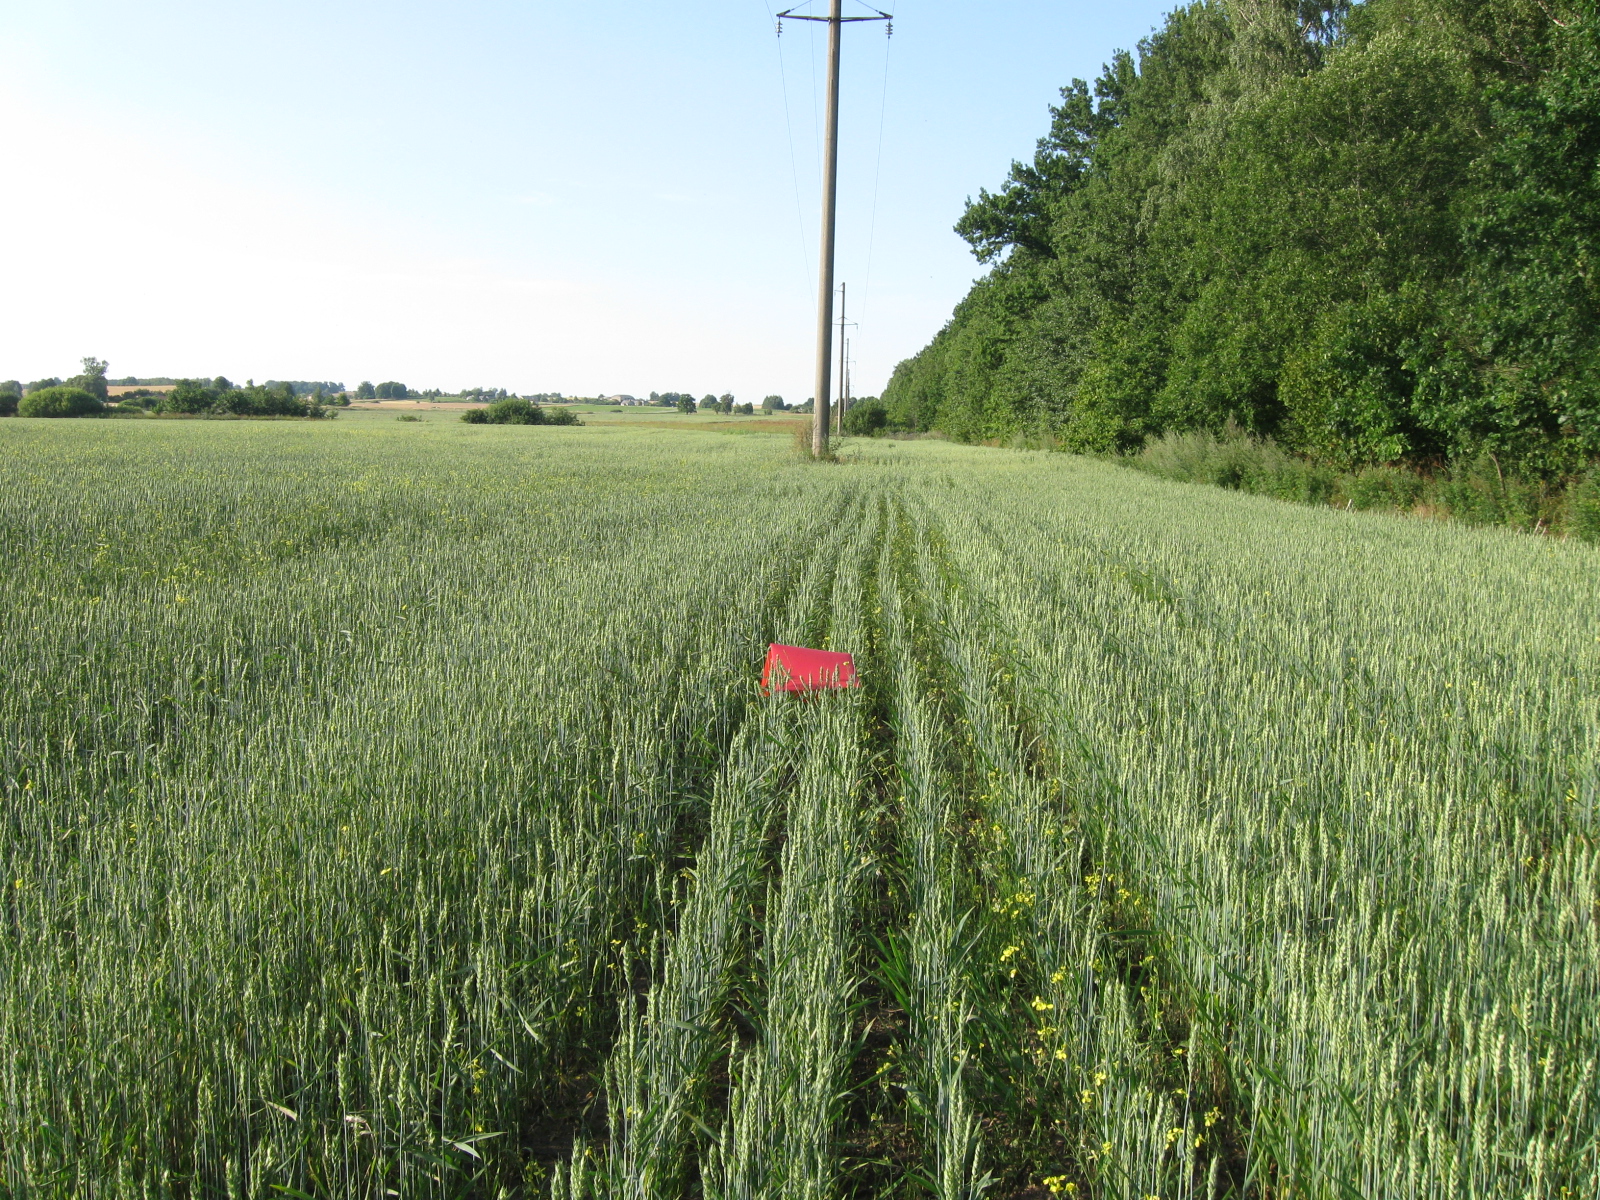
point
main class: Cropland
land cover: Common wheat
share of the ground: > 75 %
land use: Agriculture (excluding fallow land and kitchen gardens)
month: July
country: LT
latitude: 54.3571
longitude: 23.3277
